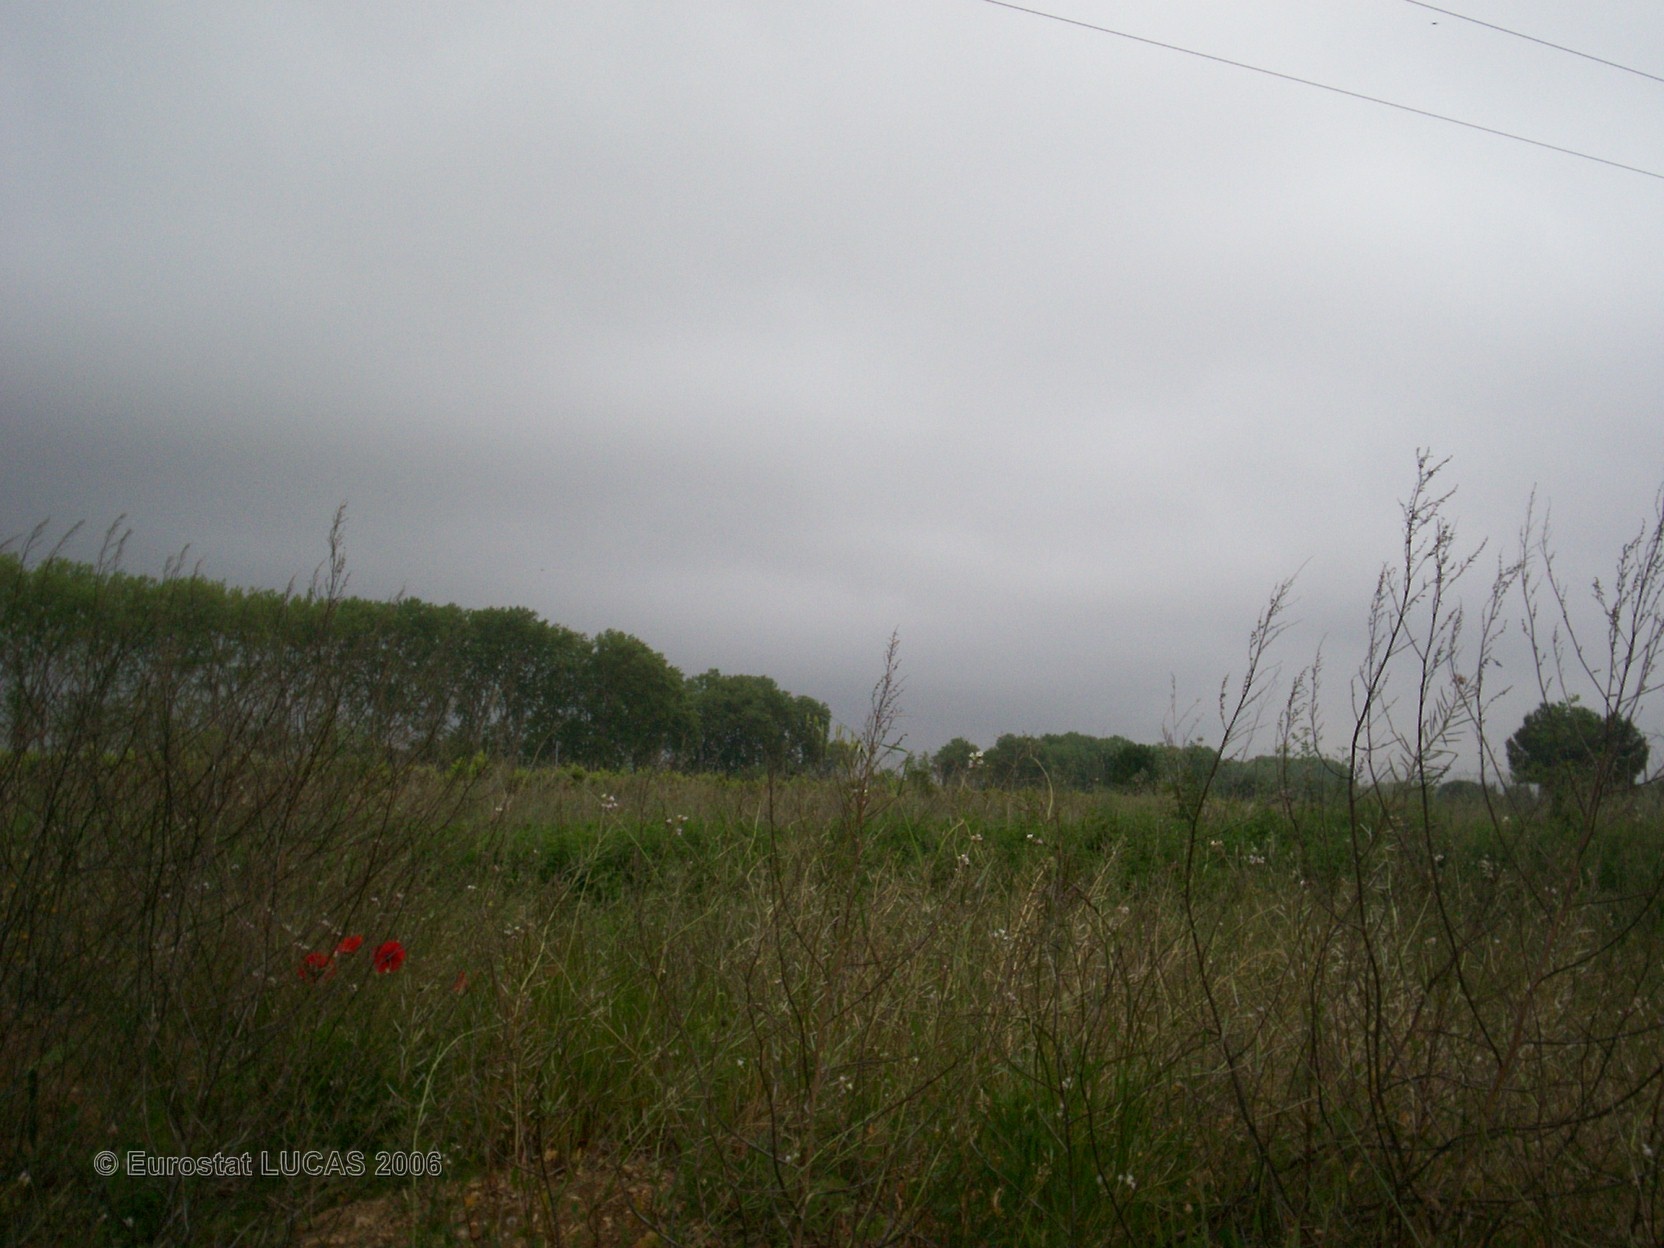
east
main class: Grassland
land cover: Grassland without tree/shrub cover
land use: Agriculture (excluding fallow land and kitchen gardens)
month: May
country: FR
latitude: 43.6565
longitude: 3.4739
